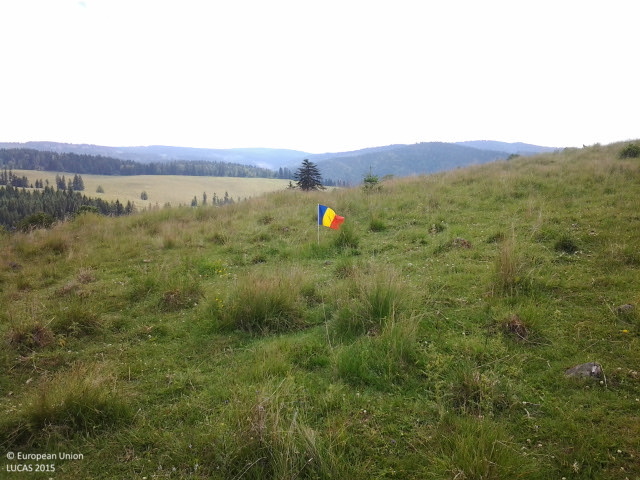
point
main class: Grassland
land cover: Grassland without tree/shrub cover
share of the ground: > 75 %
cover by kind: herbaceous plants 100 %
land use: Agriculture (excluding fallow land and kitchen gardens)
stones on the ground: 10 - 25 %
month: June
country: RO
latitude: 47.0501
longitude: 25.3392
